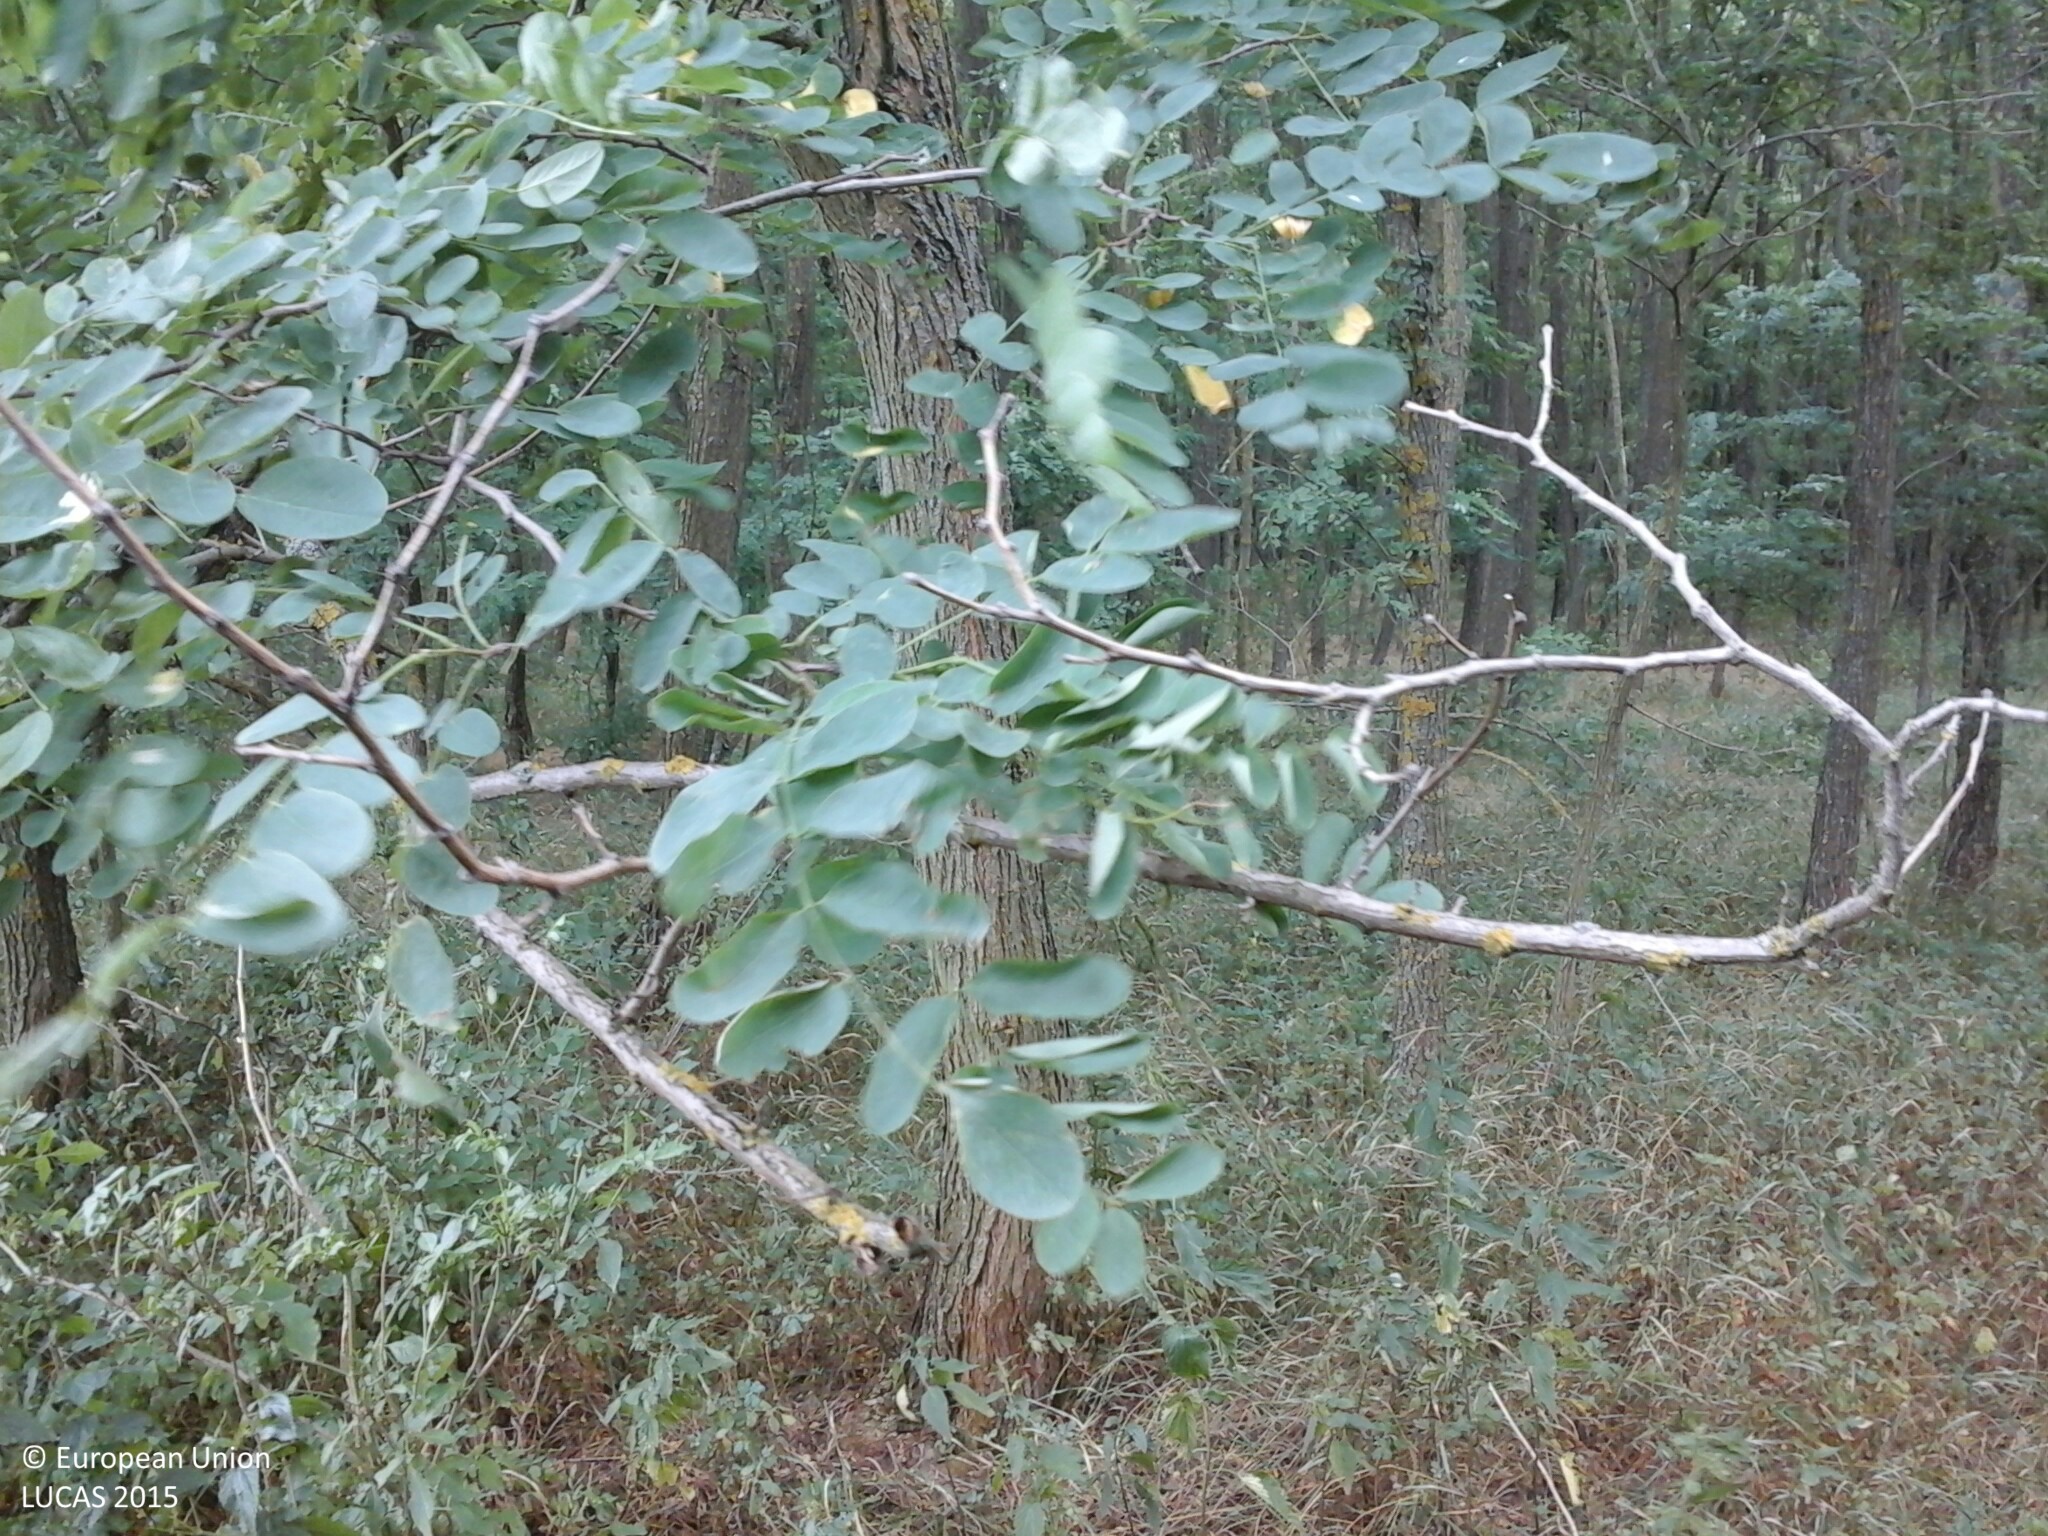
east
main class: Woodland
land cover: Broadleaved woodland
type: mesophytic deciduous forest
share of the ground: > 75 %
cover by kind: broadleaved forest trees 90 %, herbaceous plants 10 %
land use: Forestry
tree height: > 5 m
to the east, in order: Broadleaved woodland; Inland marshes; Spontaneously vegetated surfaces; Tracks; Spontaneously vegetated surfaces
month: July
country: HU
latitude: 48.3628
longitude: 22.0261
